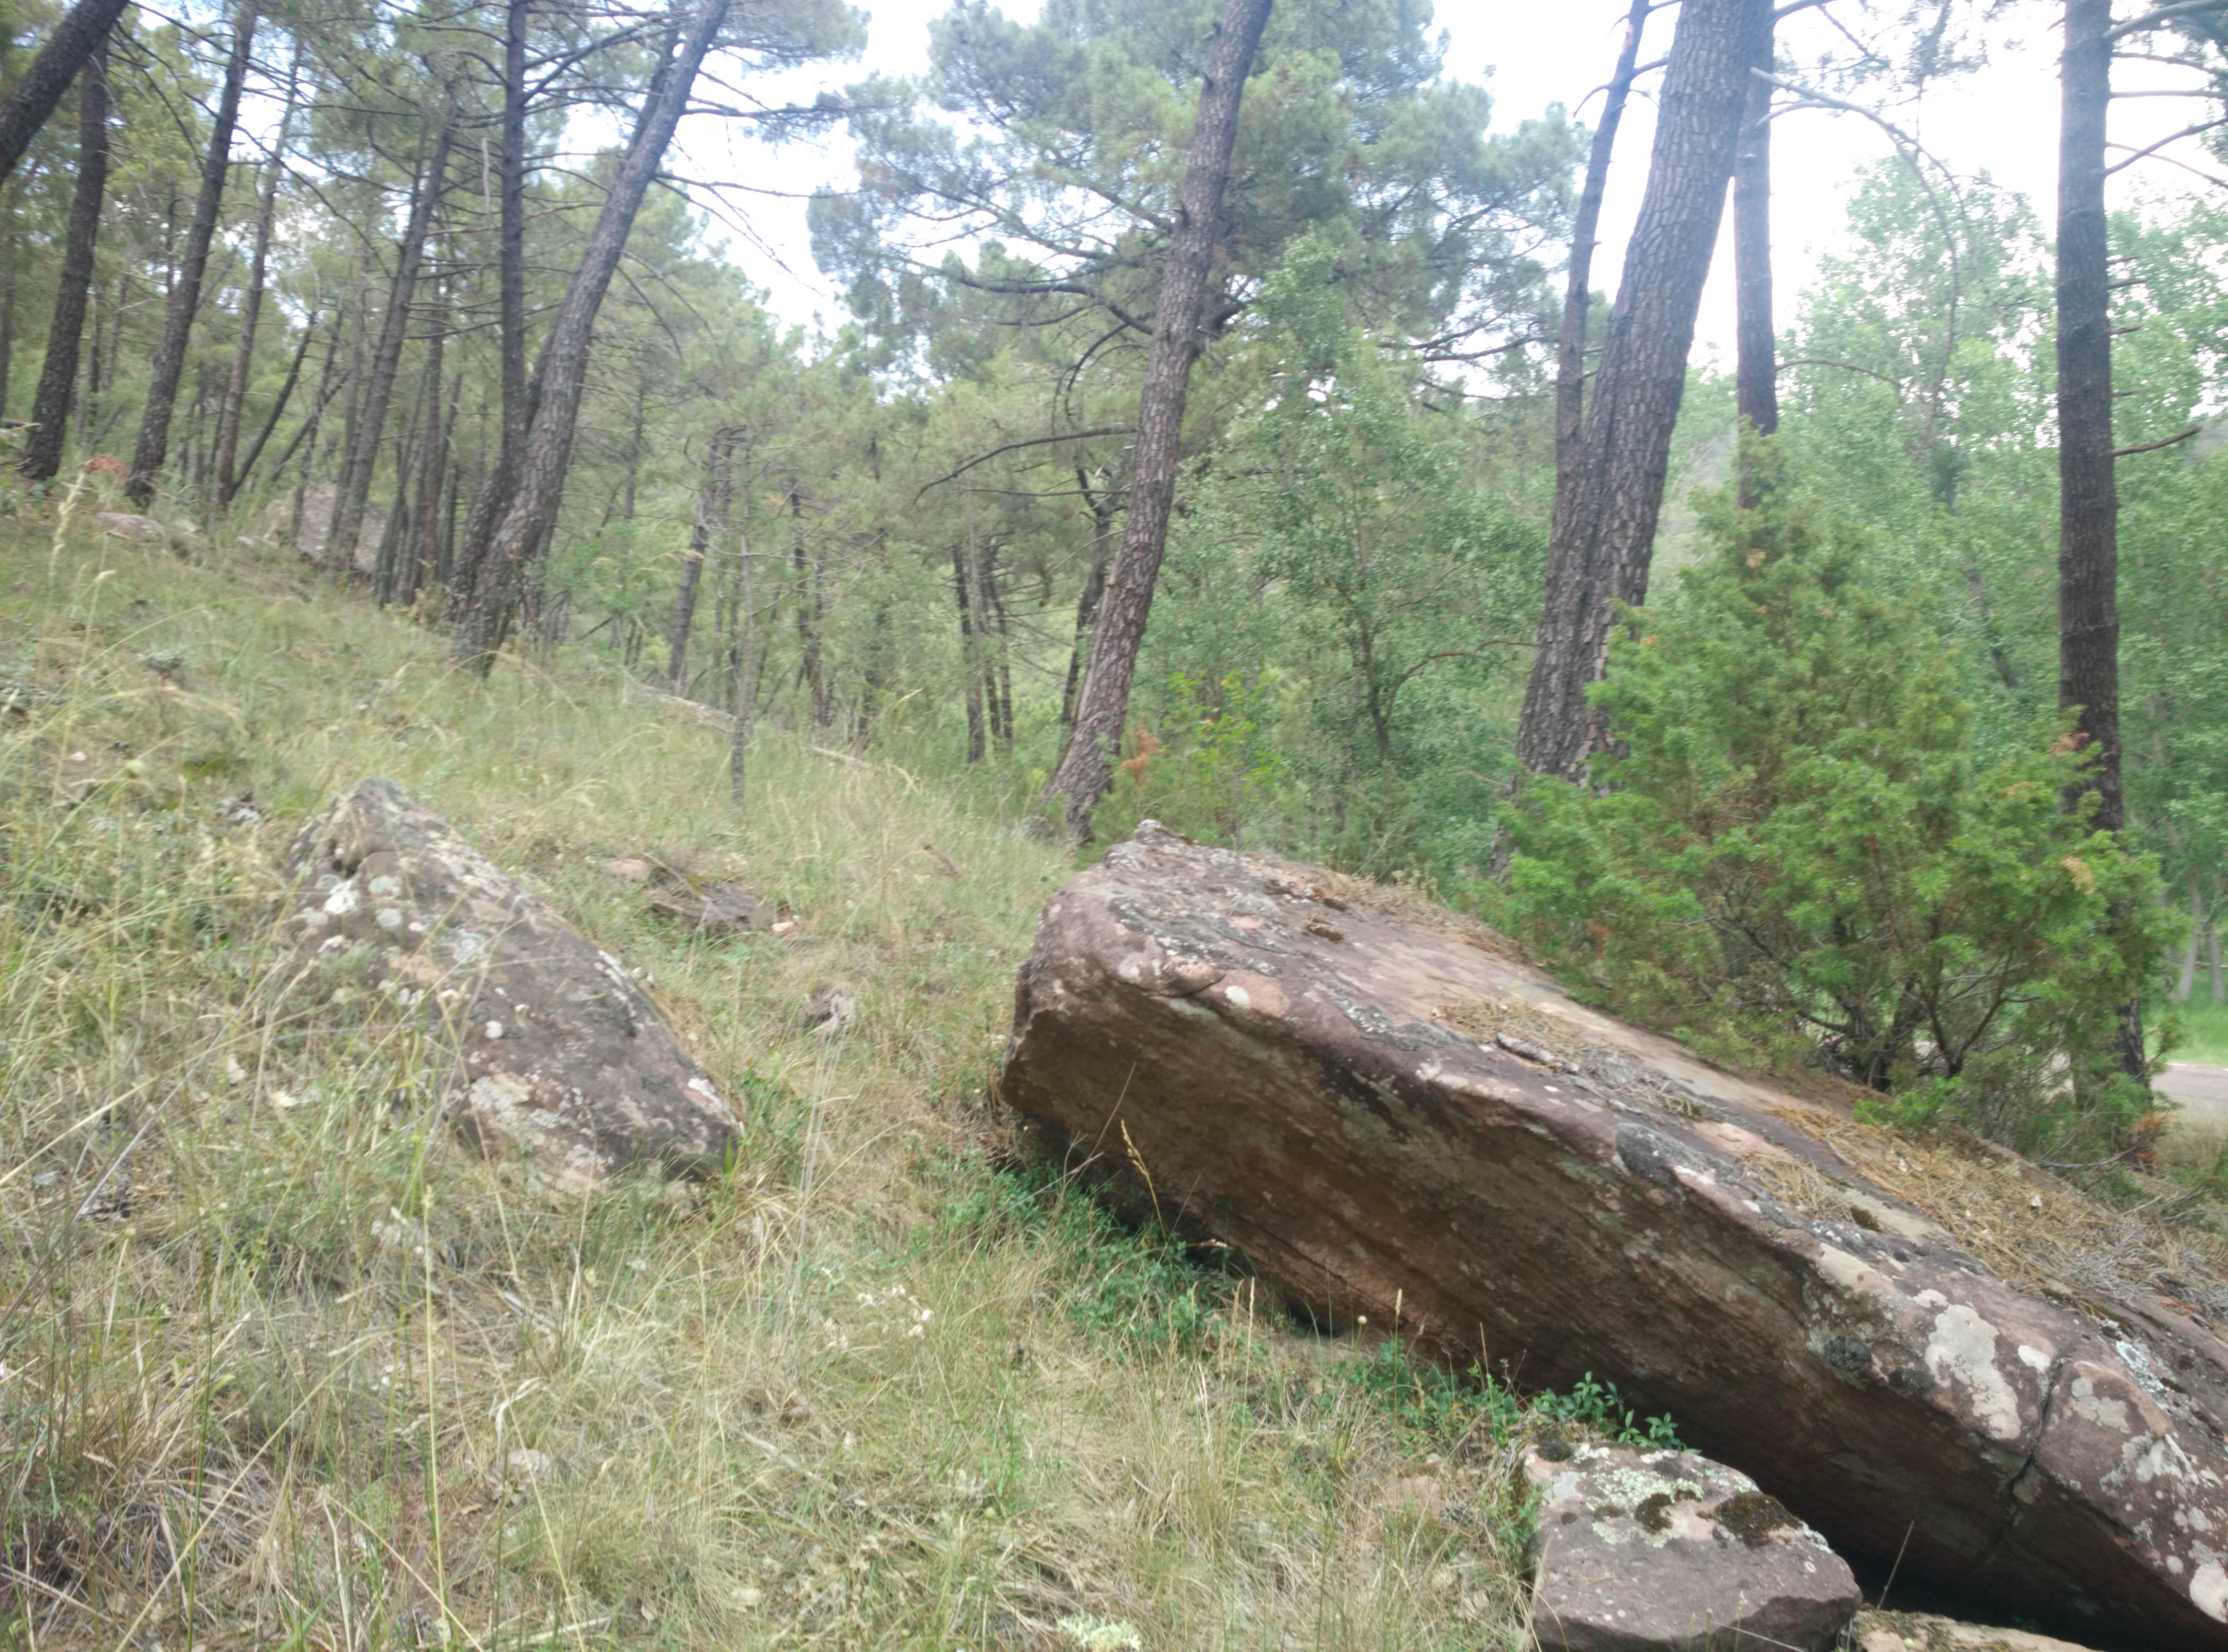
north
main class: Woodland
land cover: Pine dominated coniferous woodland
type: coniferous forest of the mediterranean region
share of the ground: 50 - 75 %
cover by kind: coniferous forest trees 60 %, unconsolidated bare surface 30 %, shrubs 10 %
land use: Semi-natural and natural areas not in use
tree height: > 5 m
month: July
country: ES
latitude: 40.8235
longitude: -2.0105
